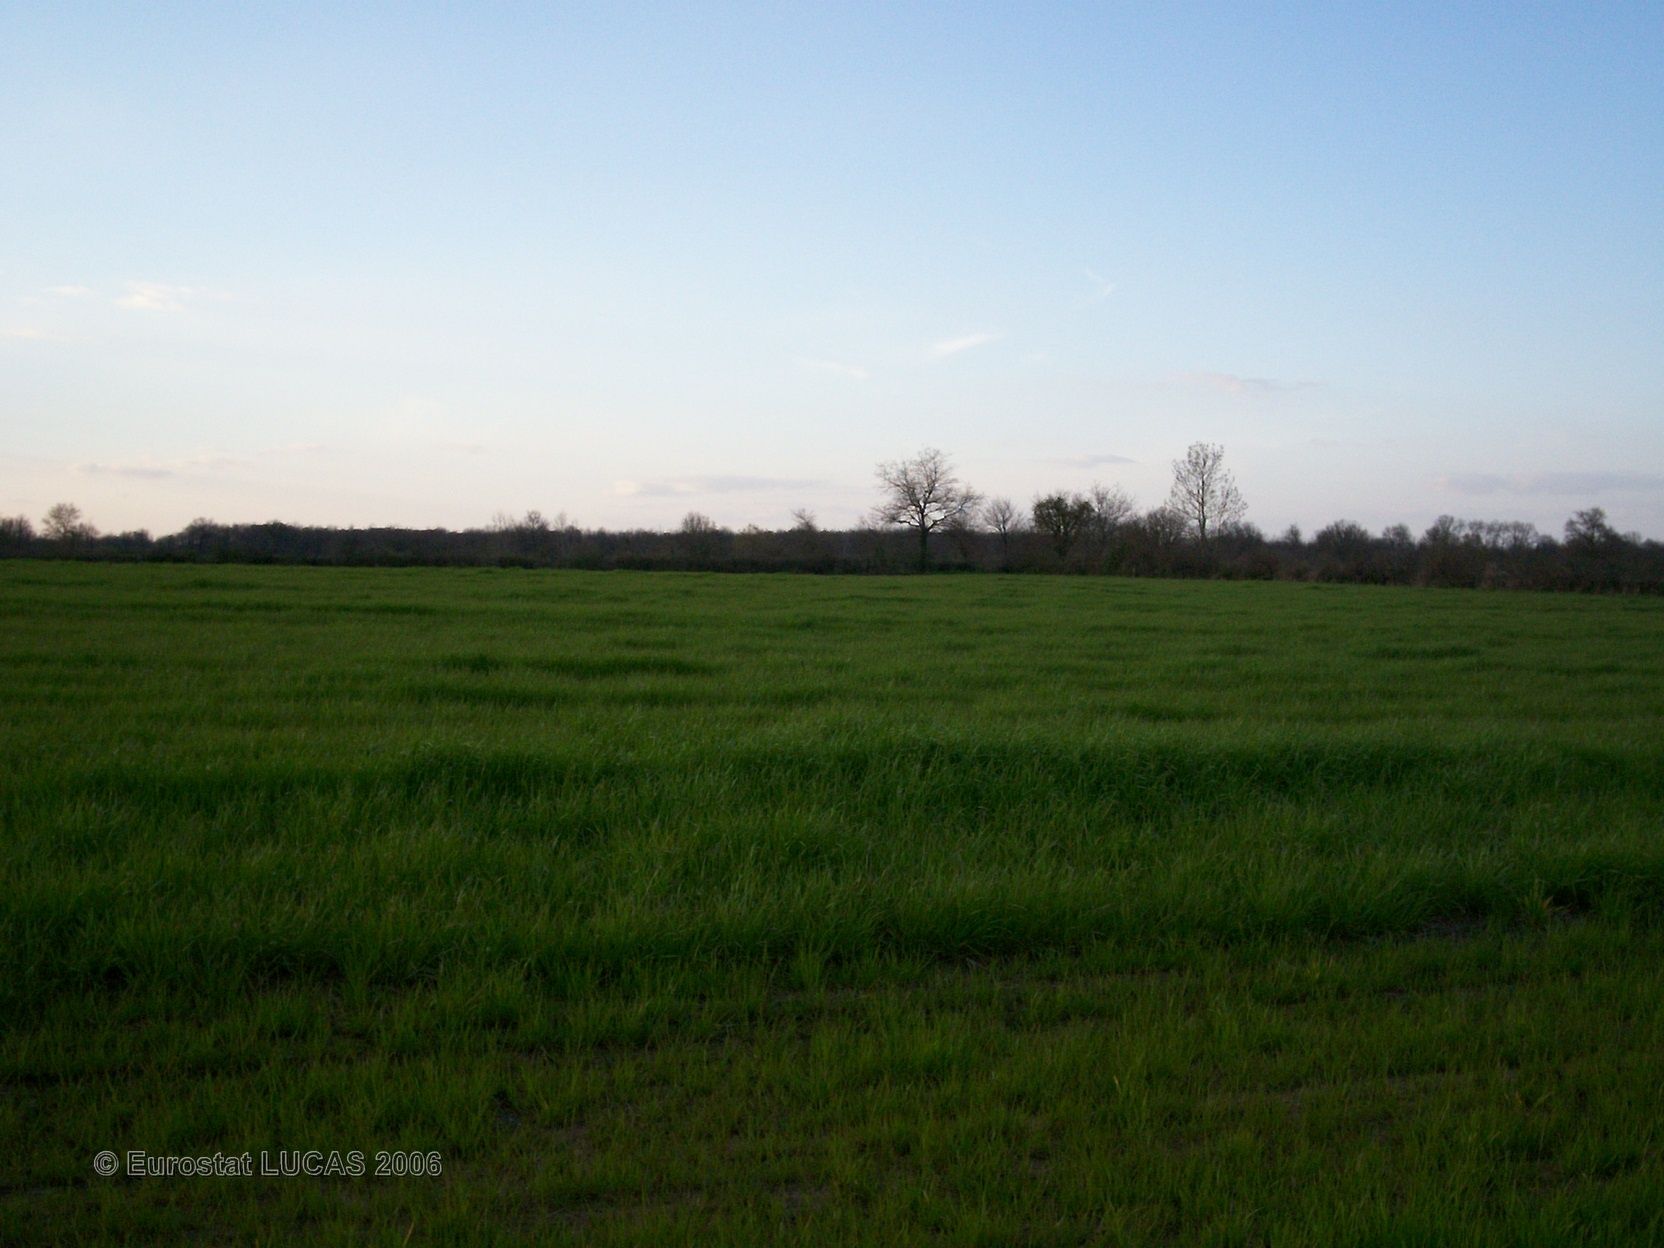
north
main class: Grassland
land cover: Grassland without tree/shrub cover
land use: Agriculture (excluding fallow land and kitchen gardens)
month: April
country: FR
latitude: 46.7598
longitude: -0.3035
